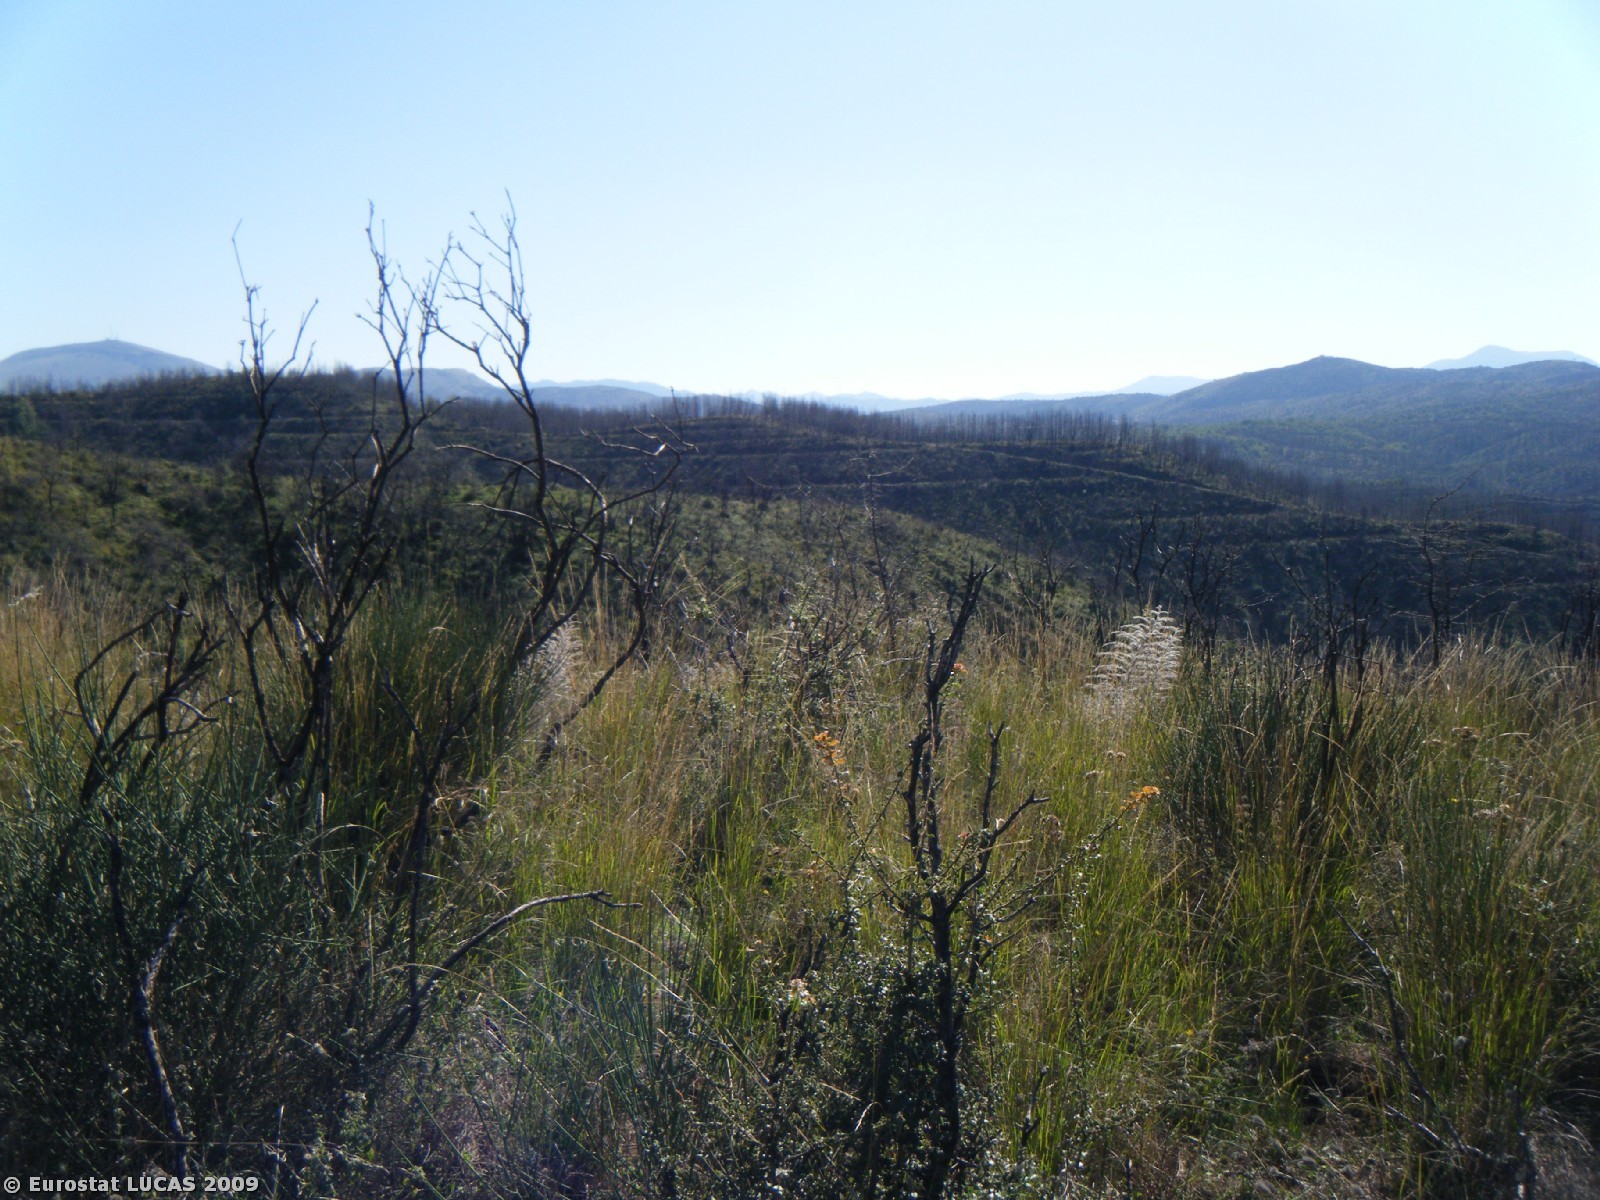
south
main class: Grassland
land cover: Grassland with sparse tree/shrub cover
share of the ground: > 75 %
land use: Unused
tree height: > 5 m
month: October
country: GR
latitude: 37.4324
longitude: 22.2217
